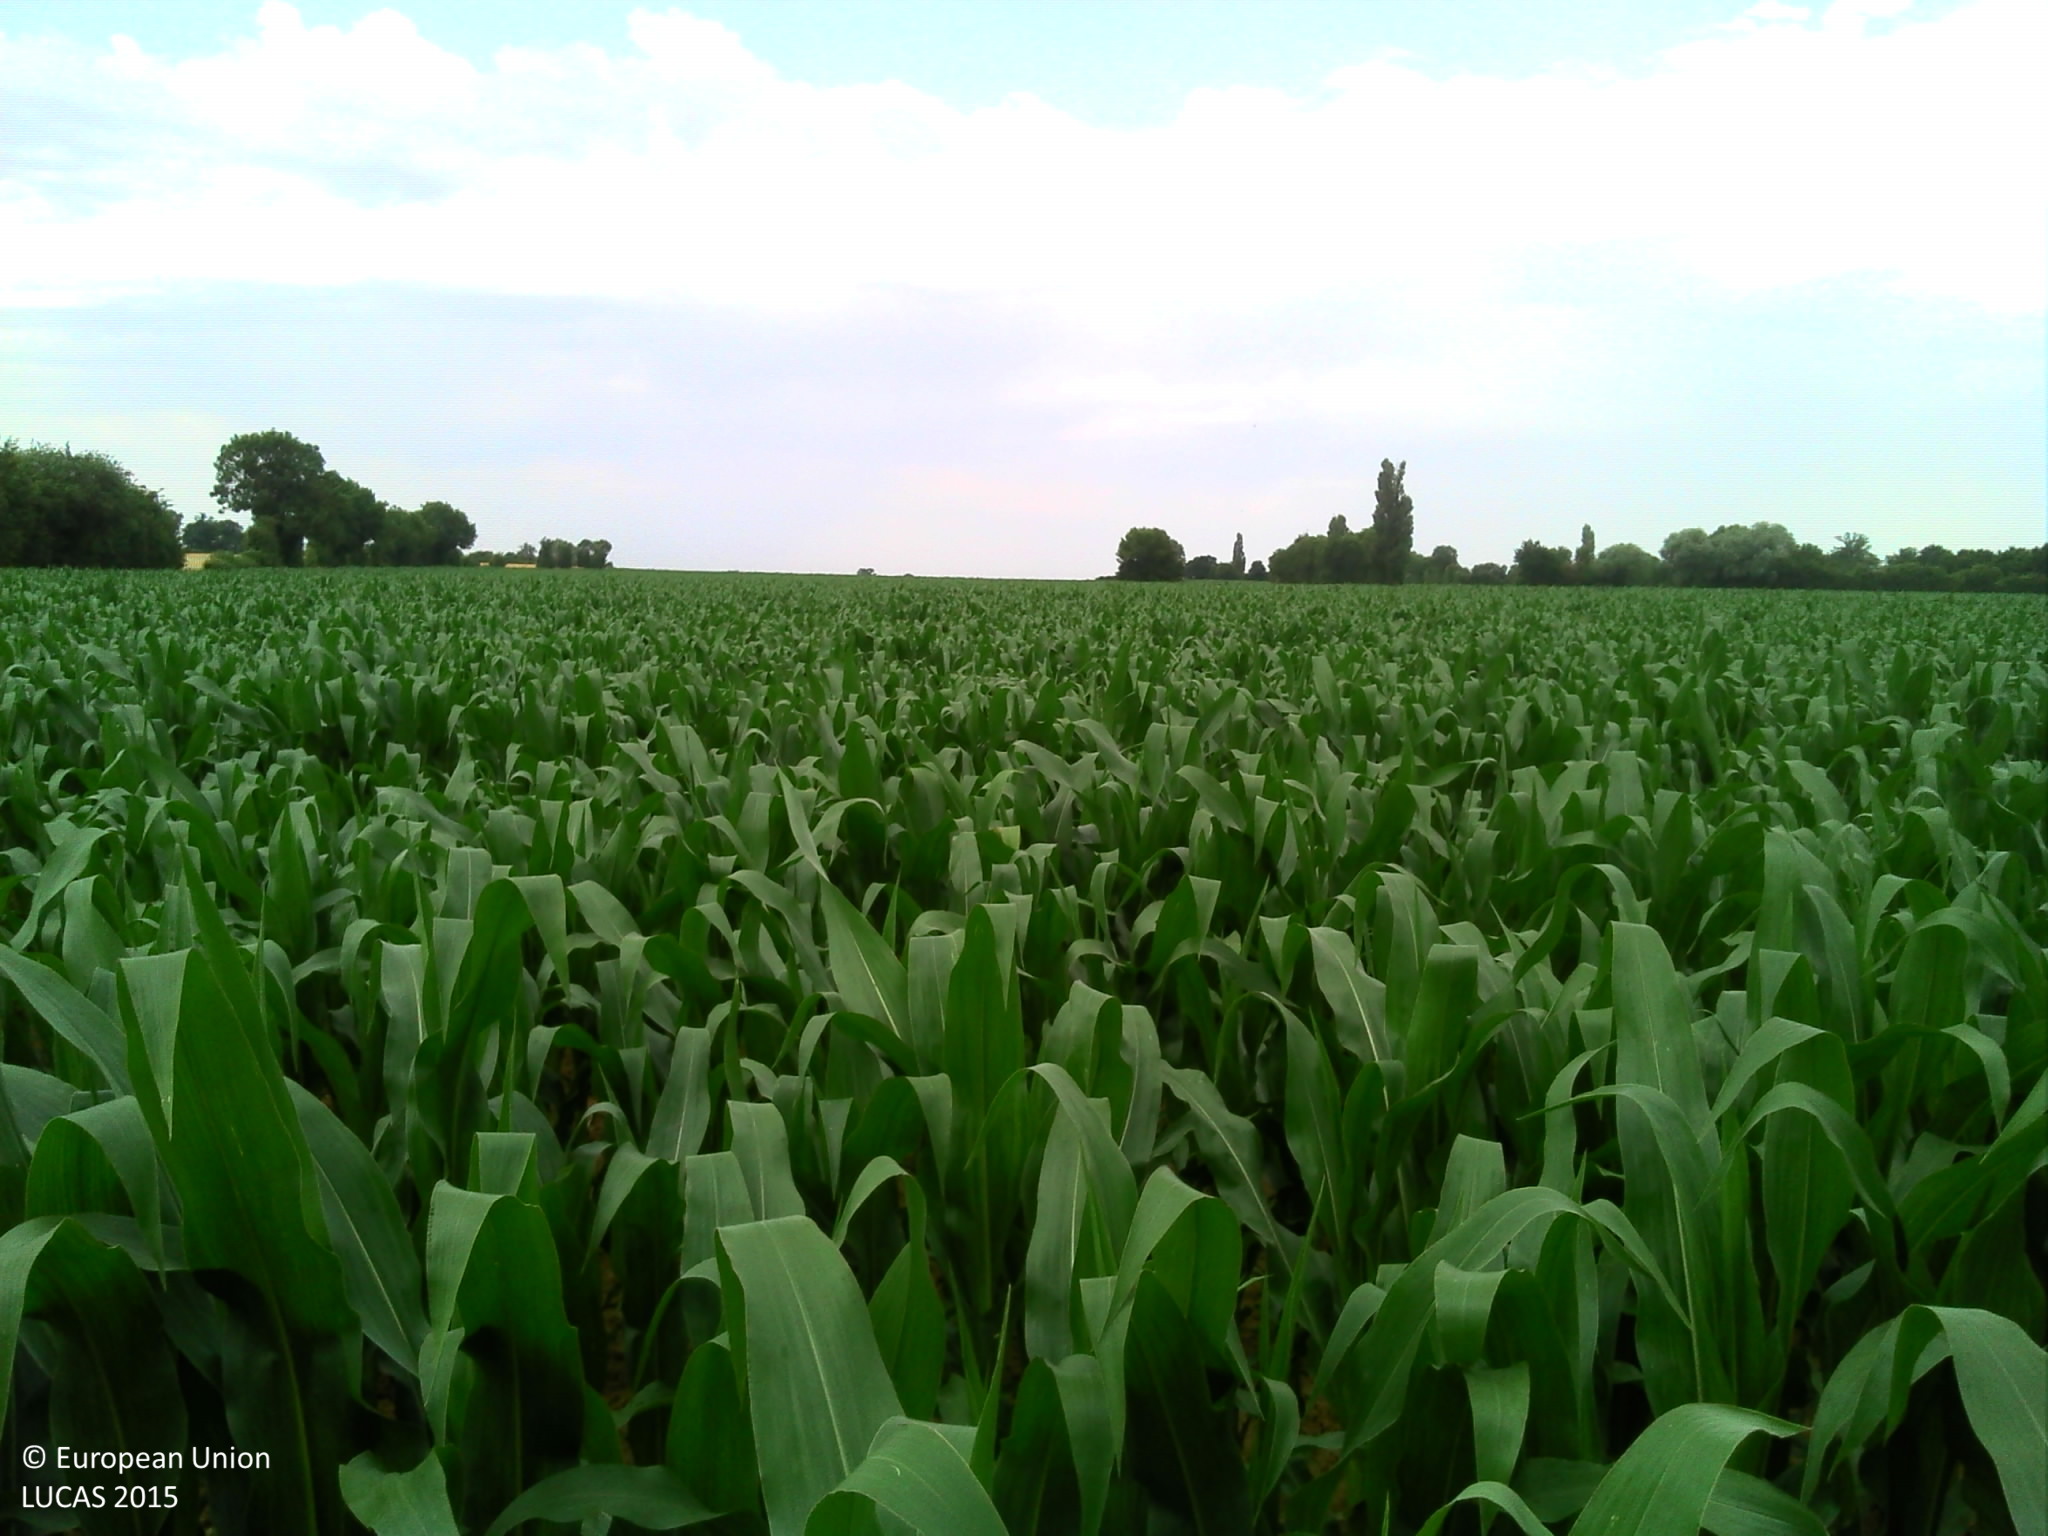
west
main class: Cropland
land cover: Maize
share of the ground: > 75 %
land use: Agriculture (excluding fallow land and kitchen gardens)
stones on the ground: < 10 %
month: July
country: FR
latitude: 48.9653
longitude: 0.0118
